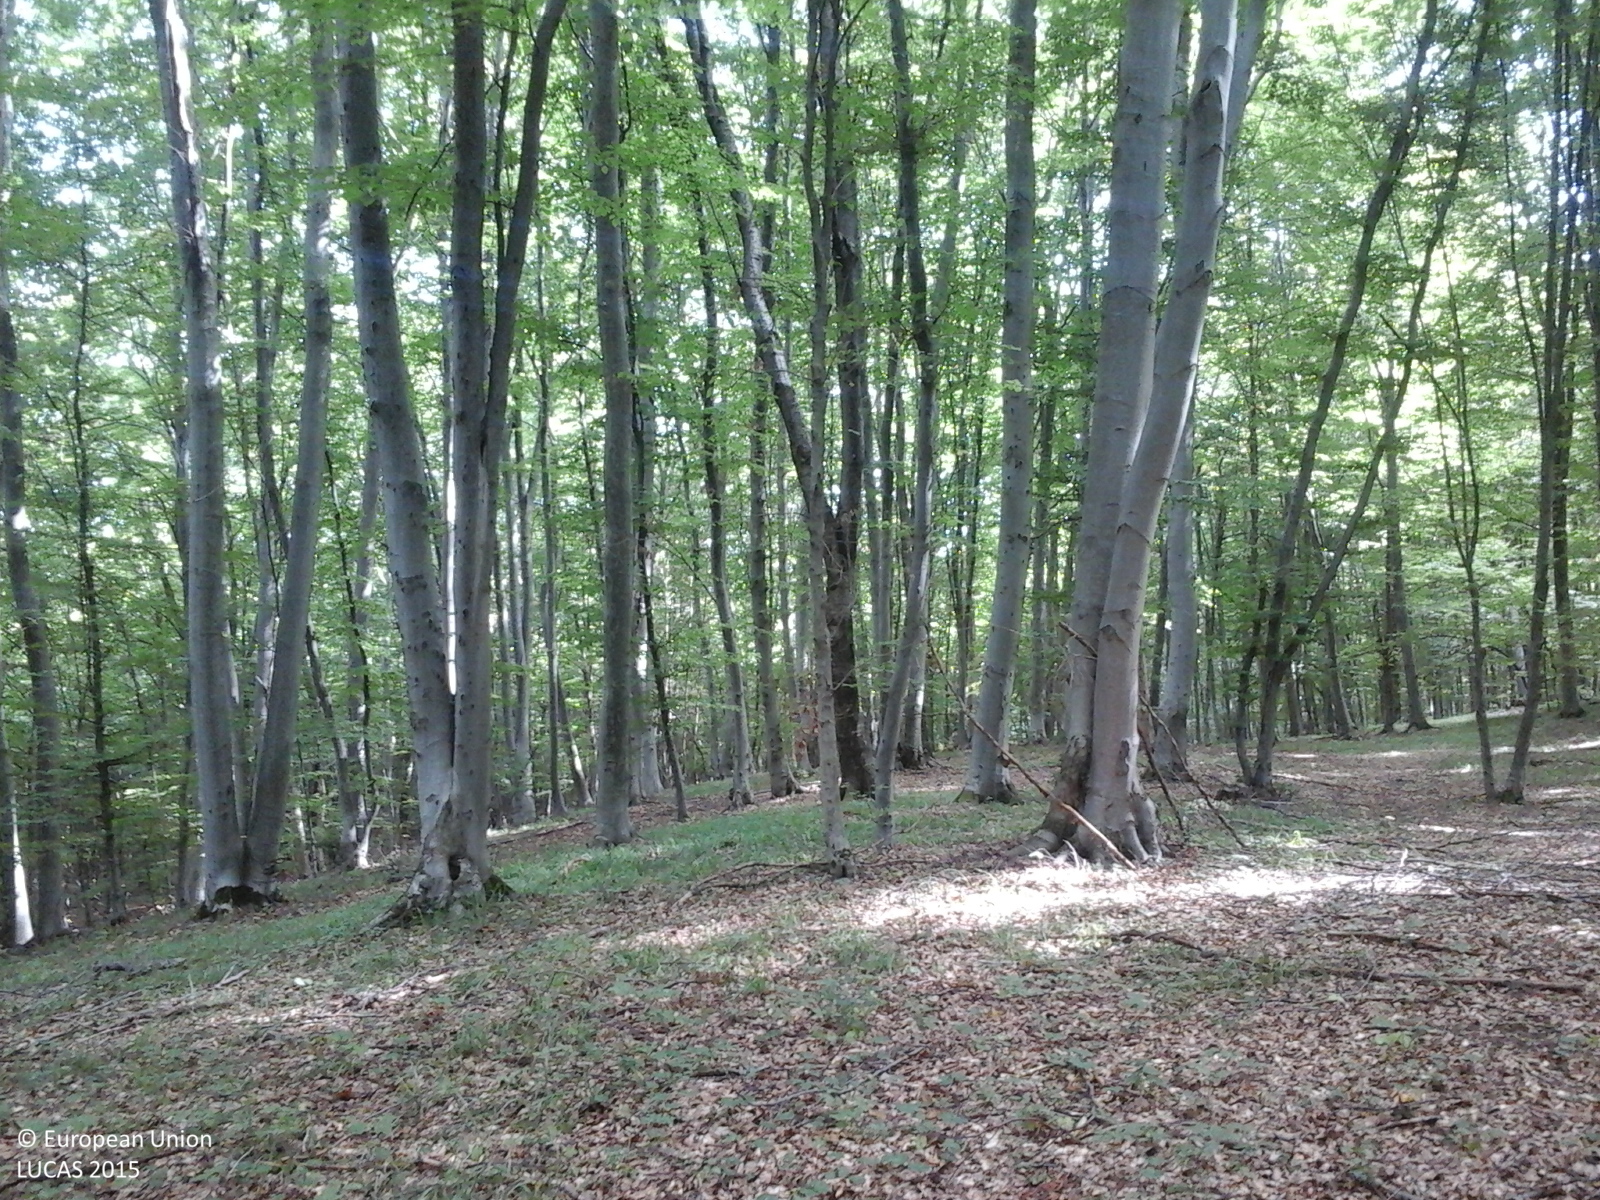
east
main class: Woodland
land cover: Broadleaved woodland
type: beech forest
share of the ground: > 75 %
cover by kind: broadleaved forest trees 100 %
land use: Forestry
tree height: > 5 m
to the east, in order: Broadleaved woodland; Tracks; Ditches and canals; Broadleaved woodland
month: September
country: RO
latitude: 46.7064
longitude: 23.5552
